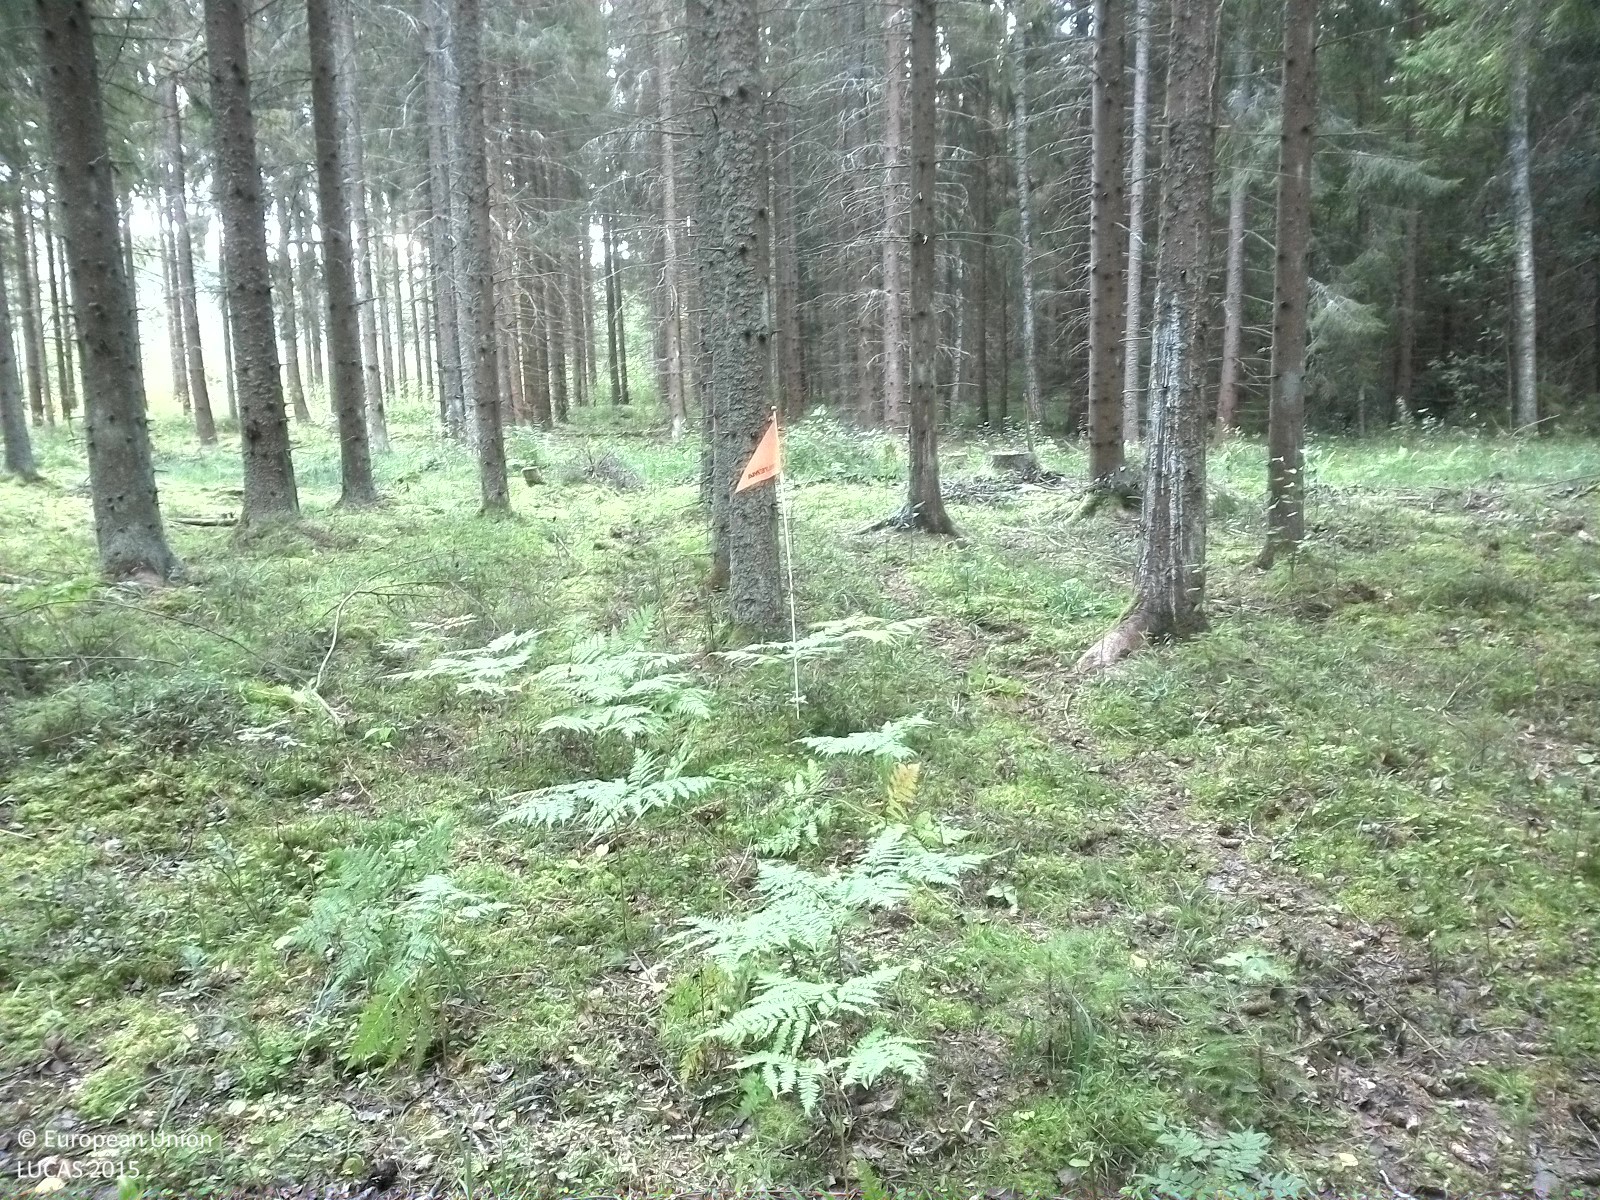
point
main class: Woodland
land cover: Spruce dominated coniferous woodland
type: boreal forest
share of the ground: 25 - 50 %
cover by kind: coniferous forest trees 40 %, lichens and mosses 30 %, herbaceous plants 25 %, broadleaved forest trees 5 %
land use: Forestry
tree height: > 5 m
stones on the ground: < 10 %
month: August
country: SE
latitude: 59.1475
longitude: 15.6392
